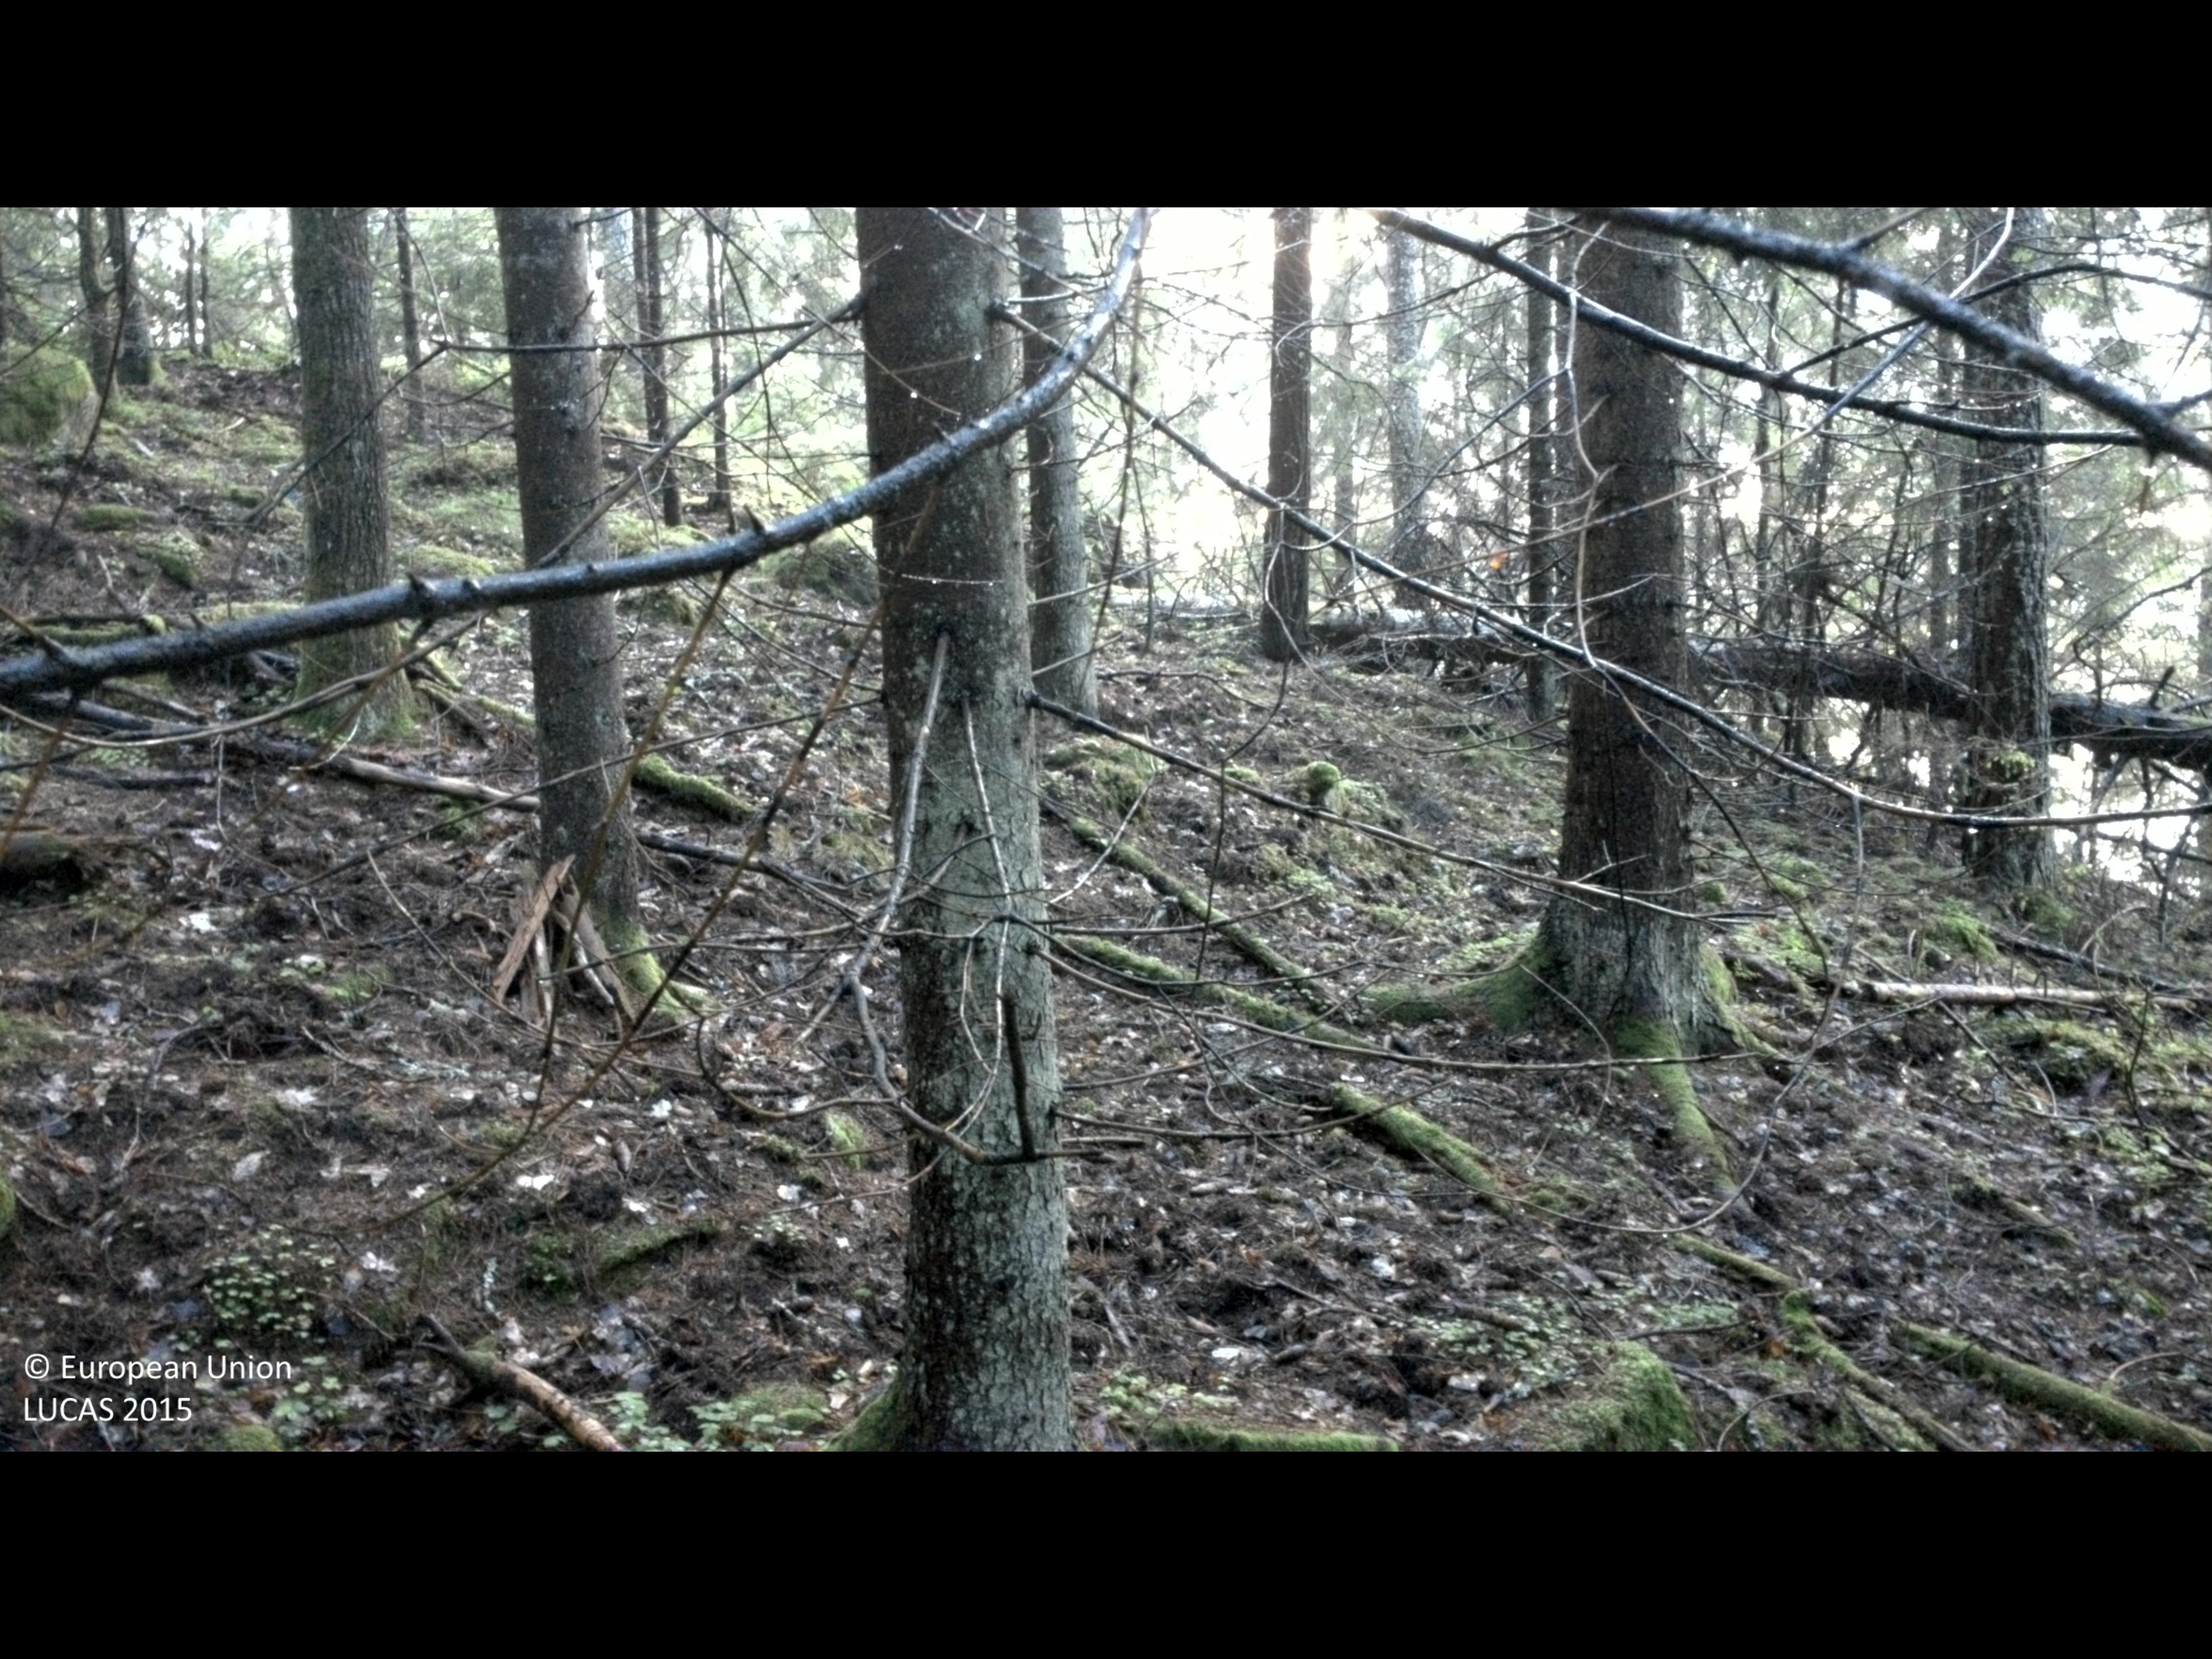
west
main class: Woodland
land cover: Other mixed woodland
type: boreal forest
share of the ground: > 75 %
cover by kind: coniferous forest trees 45 %, broadleaved forest trees 35 %, shrubs 10 %, lichens and mosses 10 %
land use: Forestry
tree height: > 5 m
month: June
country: SE
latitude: 57.9129
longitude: 16.2253
